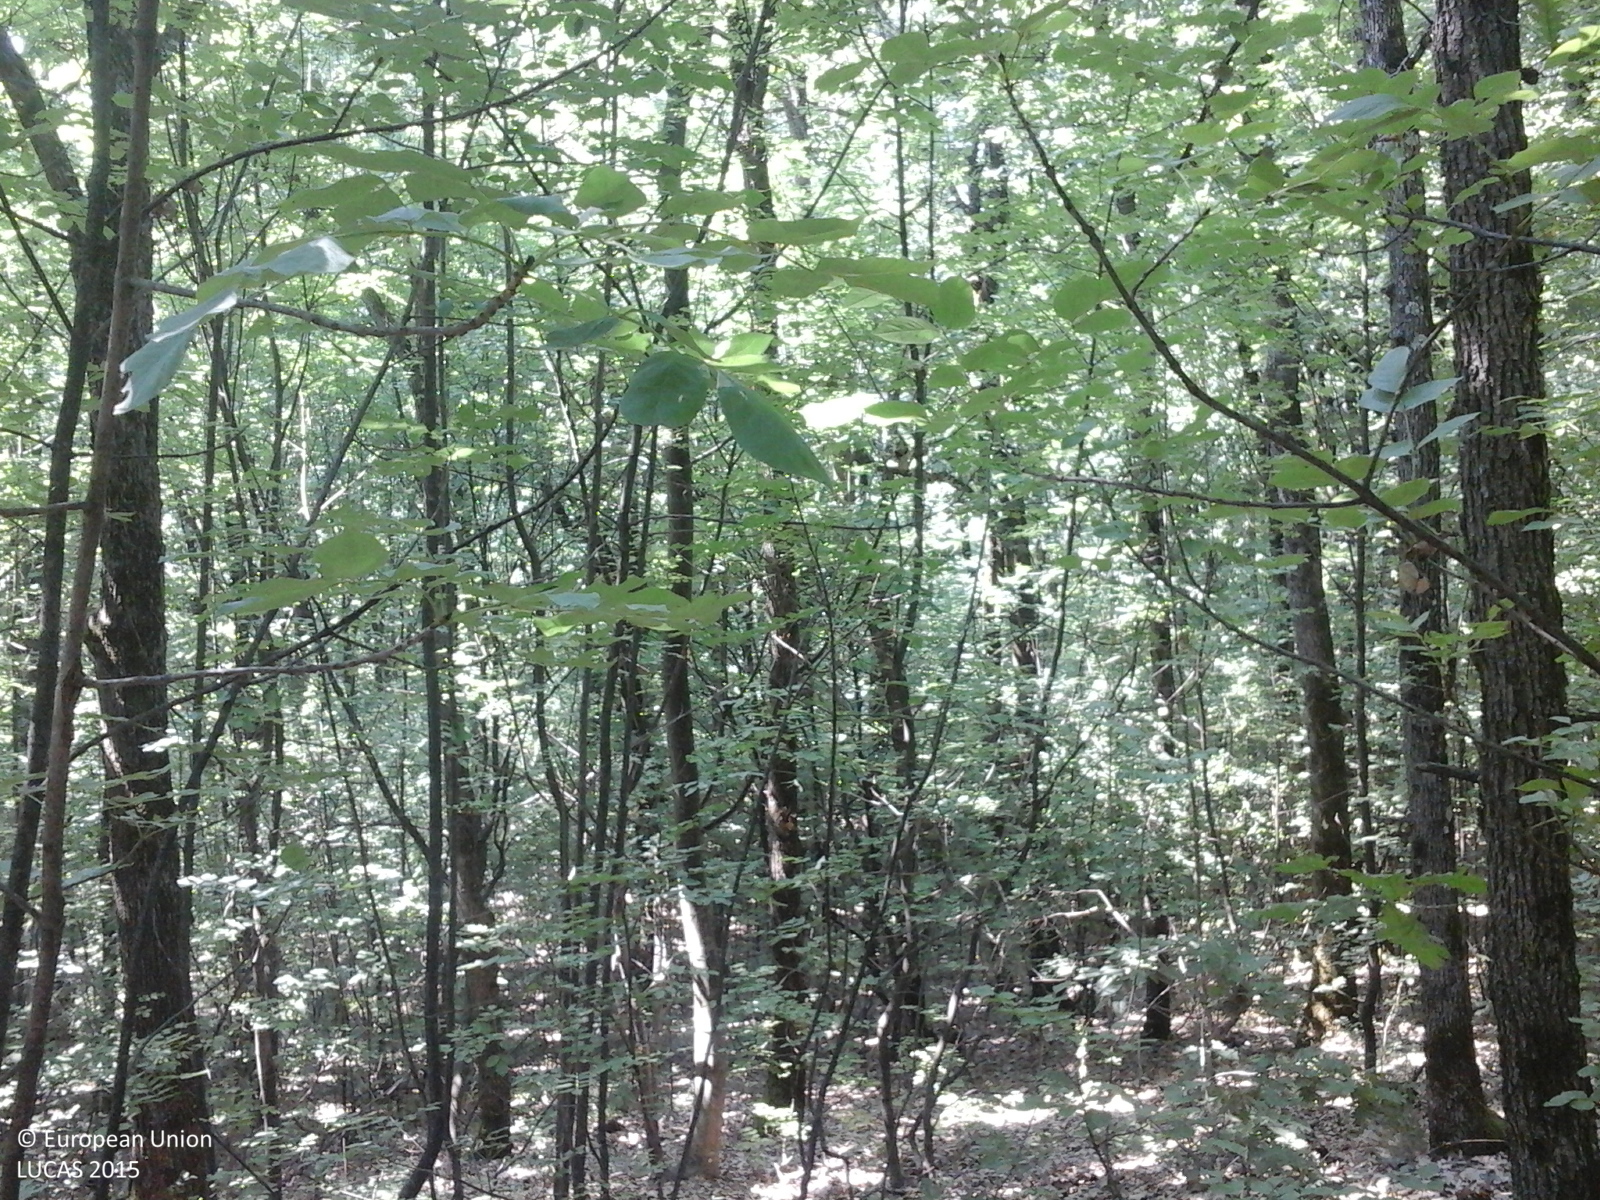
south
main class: Woodland
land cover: Broadleaved woodland
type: beech forest
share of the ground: > 75 %
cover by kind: broadleaved forest trees 100 %
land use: Forestry
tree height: > 5 m
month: July
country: RO
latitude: 44.7478
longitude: 24.4072
